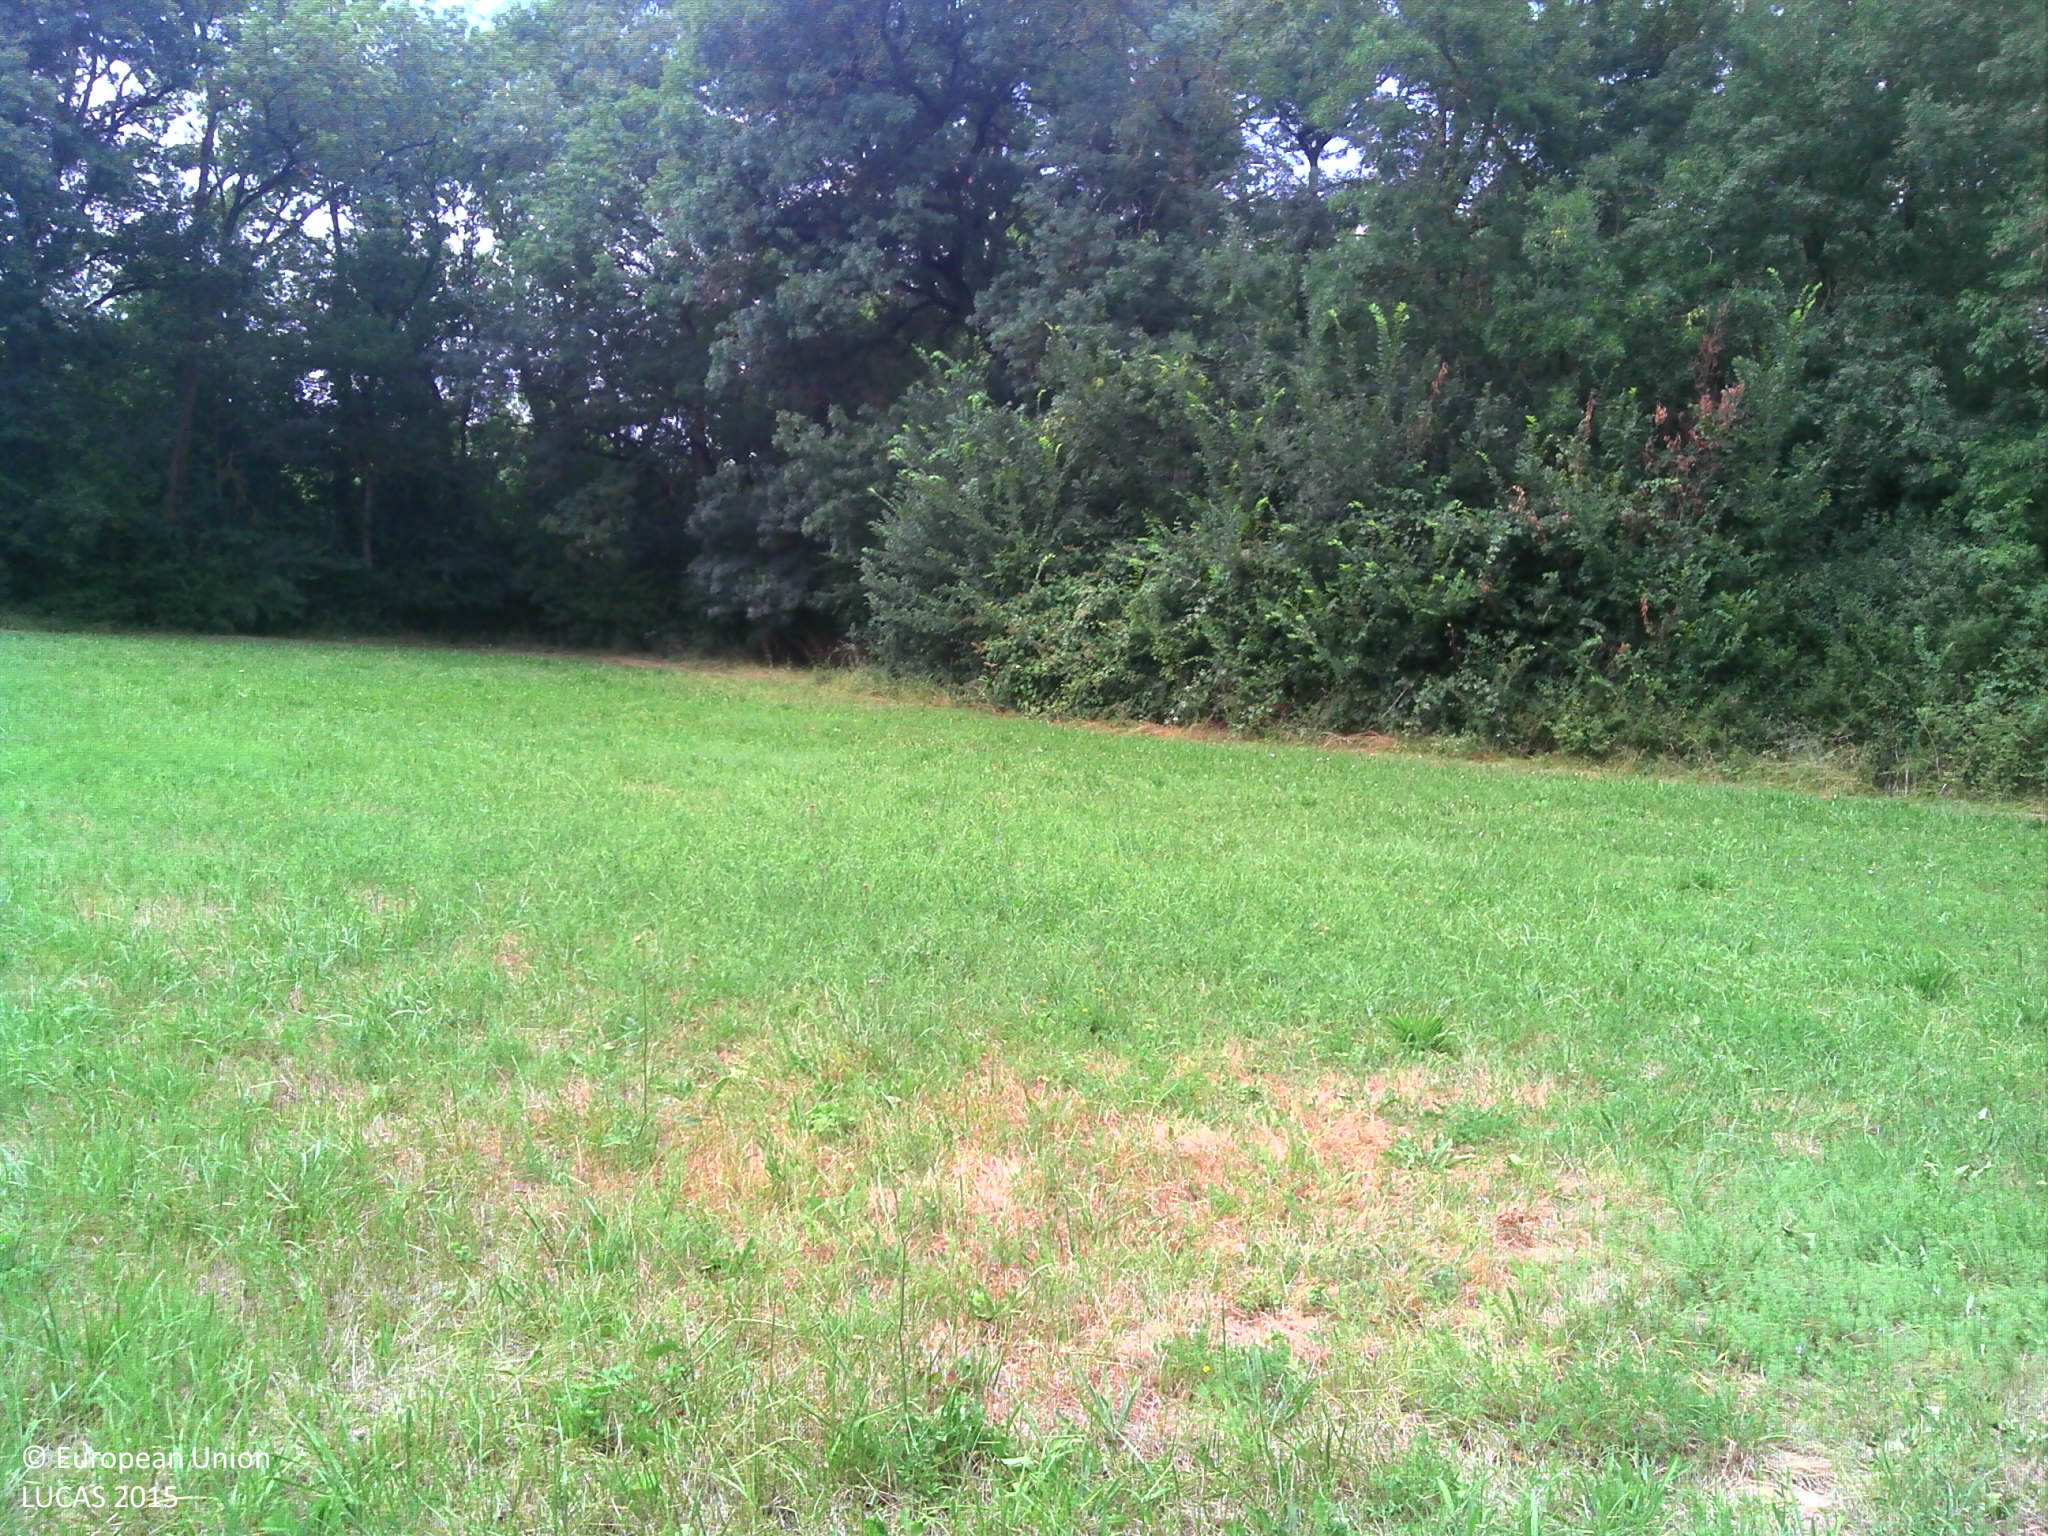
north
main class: Grassland
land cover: Grassland without tree/shrub cover
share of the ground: > 75 %
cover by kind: herbaceous plants 100 %
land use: Agriculture (excluding fallow land and kitchen gardens)
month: July
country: FR
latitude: 43.8059
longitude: 0.9121
